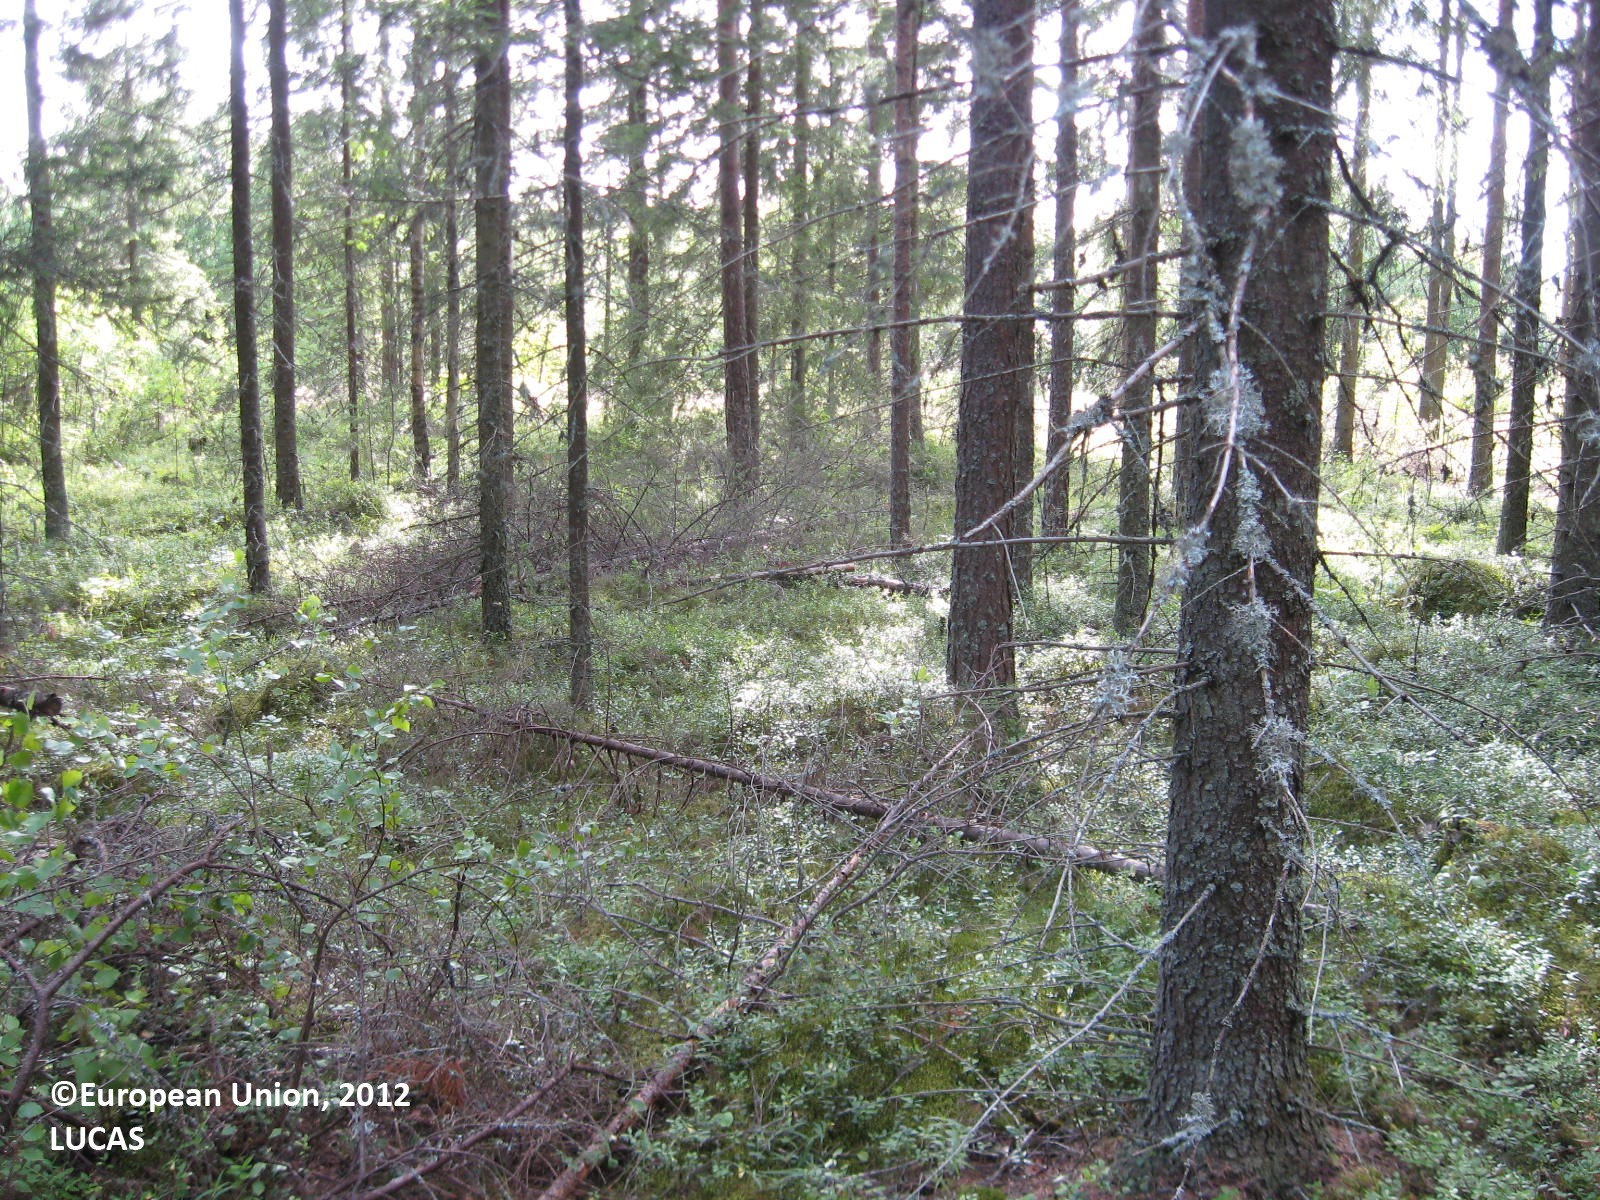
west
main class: Woodland
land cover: Spruce dominated coniferous woodland
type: boreal forest
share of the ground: > 75 %
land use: Forestry
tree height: > 5 m
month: July
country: FI
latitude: 62.0396
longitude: 21.5374
